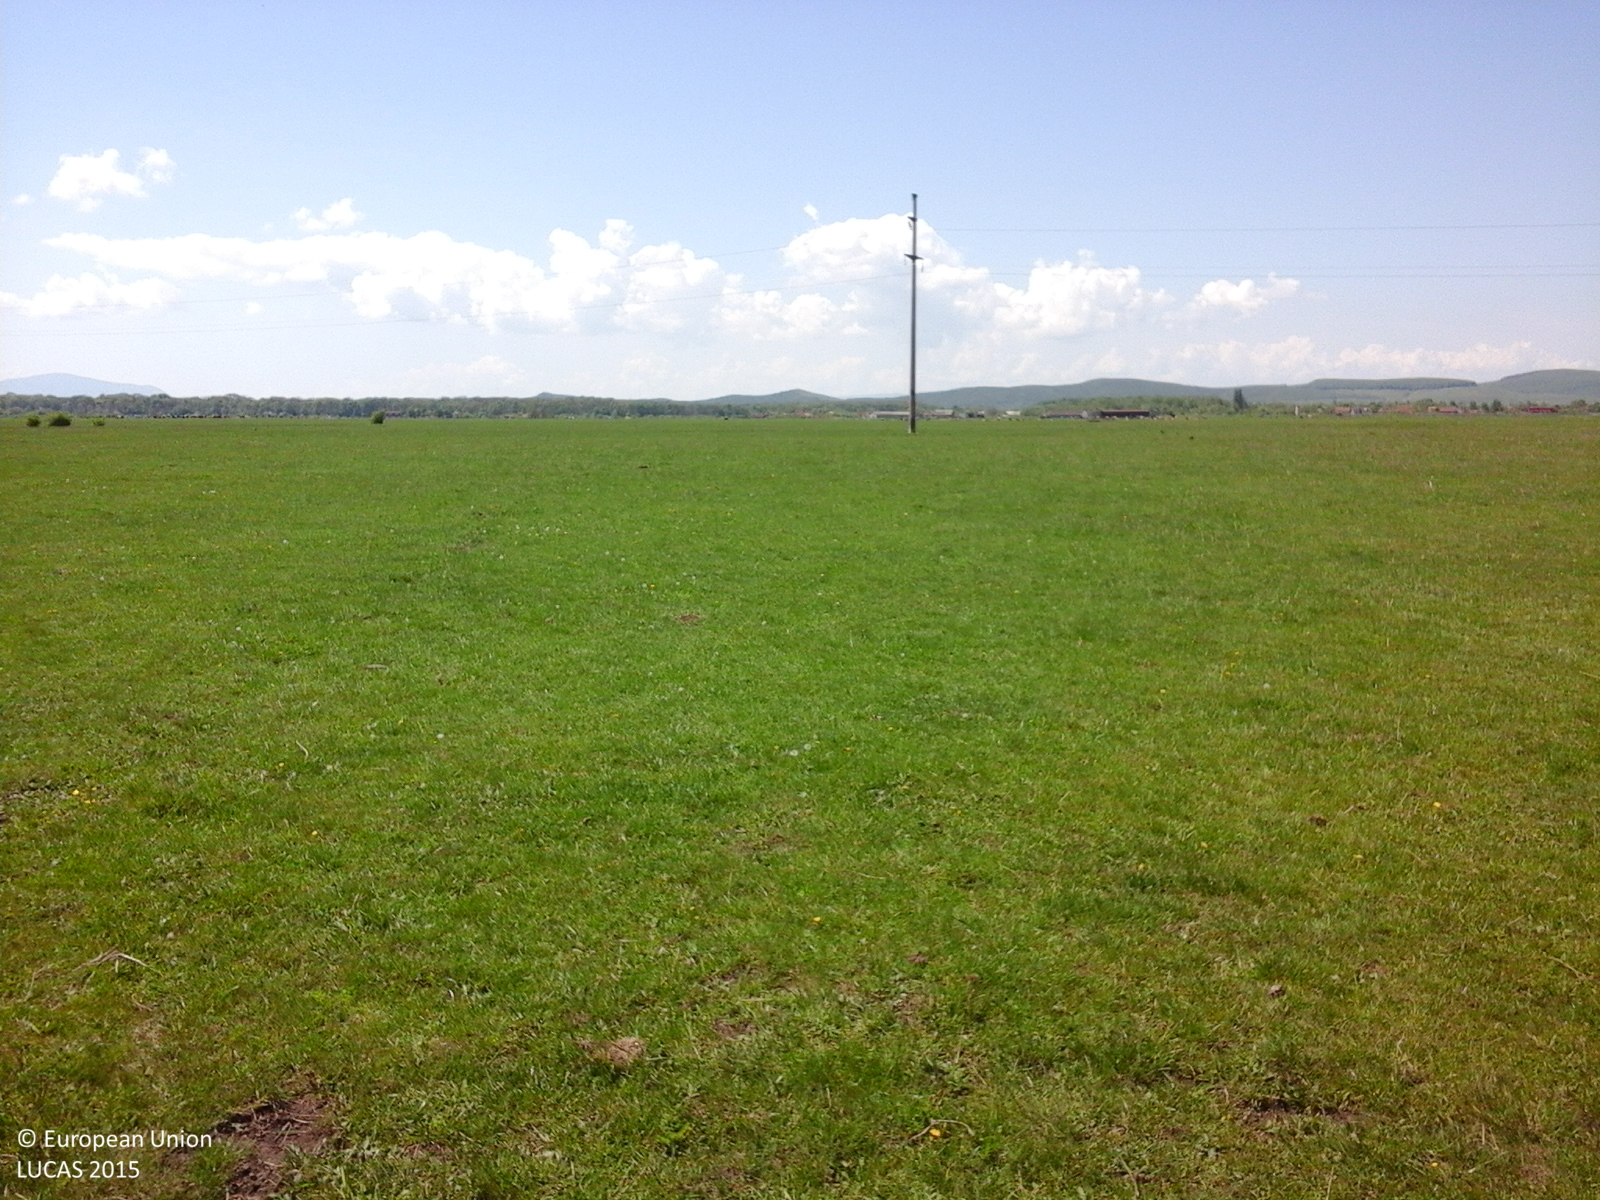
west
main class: Grassland
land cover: Grassland without tree/shrub cover
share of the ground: > 75 %
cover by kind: herbaceous plants 100 %
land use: Agriculture (excluding fallow land and kitchen gardens)
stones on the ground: < 10 %
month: May
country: RO
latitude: 45.7396
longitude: 25.7763
